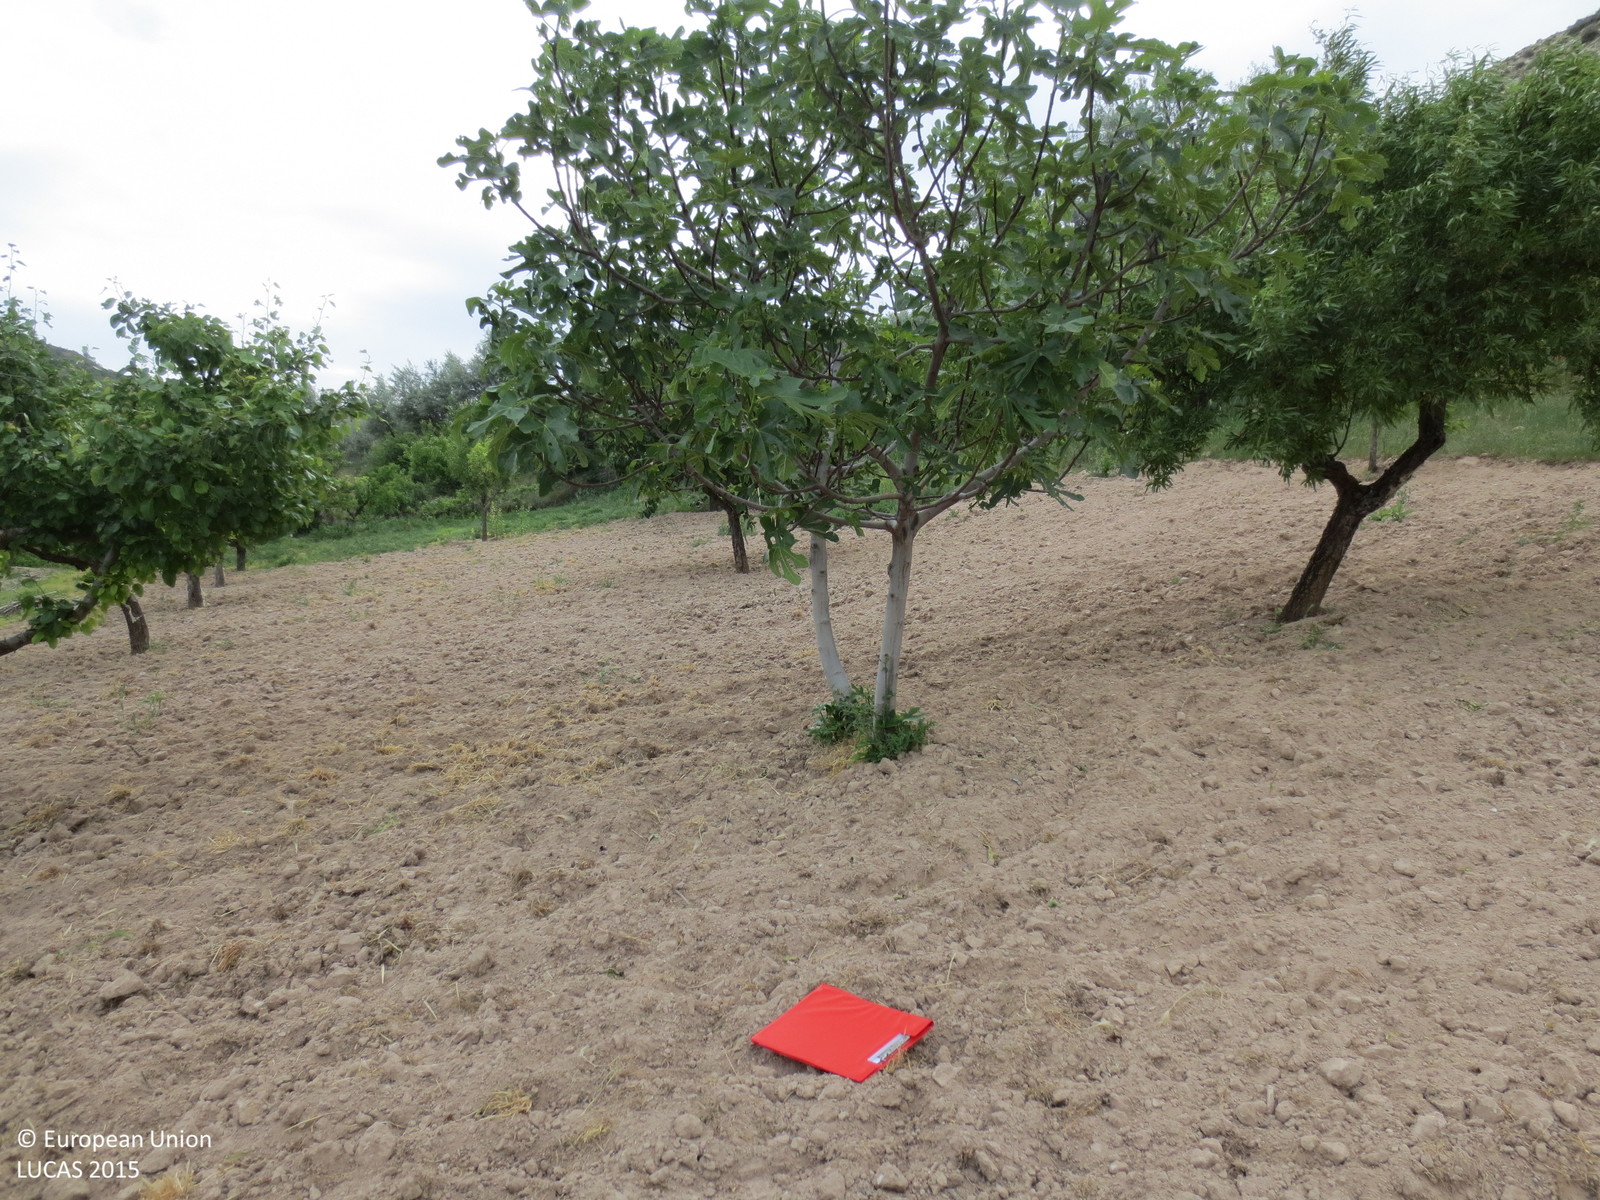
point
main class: Cropland
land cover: Nuts trees
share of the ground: 25 - 50 %
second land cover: Other fruit trees and berries
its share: 25 - 50 %
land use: Agriculture (excluding fallow land and kitchen gardens)
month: May
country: ES
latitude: 40.3761
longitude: -2.5197
